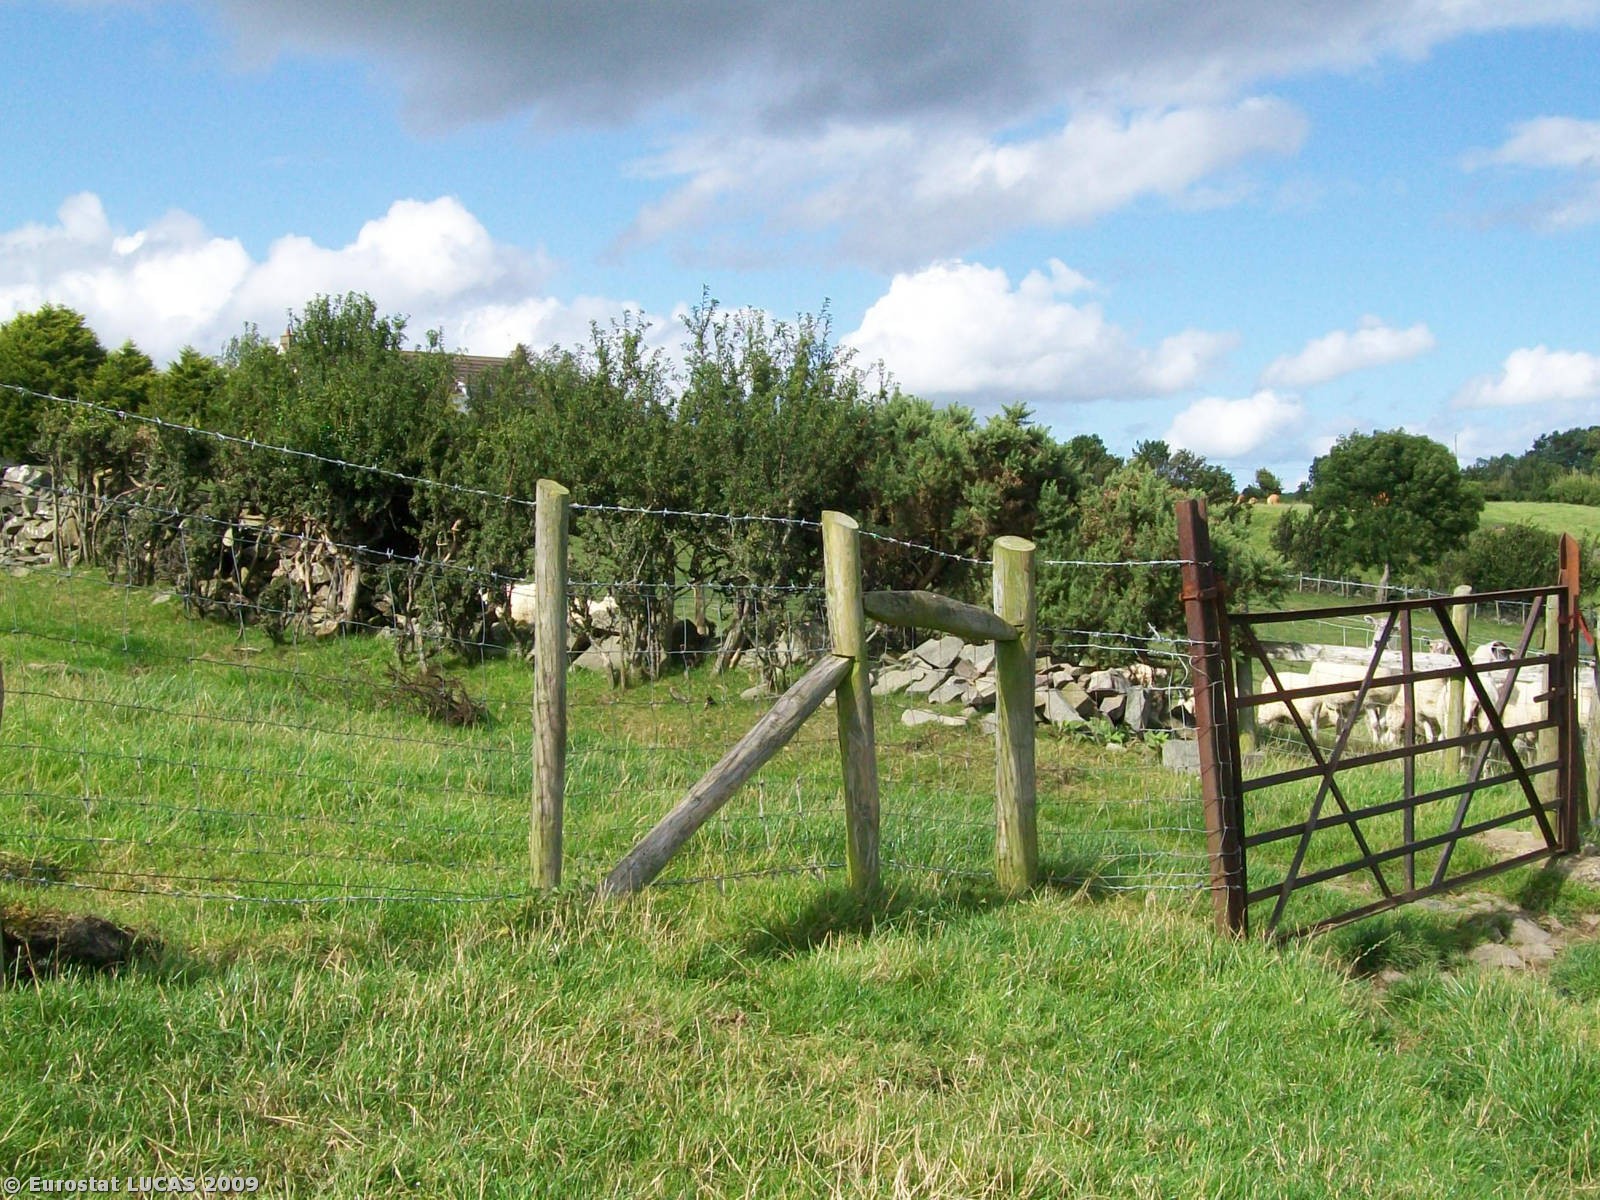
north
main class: Grassland
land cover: Grassland without tree/shrub cover
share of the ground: > 75 %
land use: Agriculture (excluding fallow land and kitchen gardens)
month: August
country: GB
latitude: 54.4639
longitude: -5.6677
